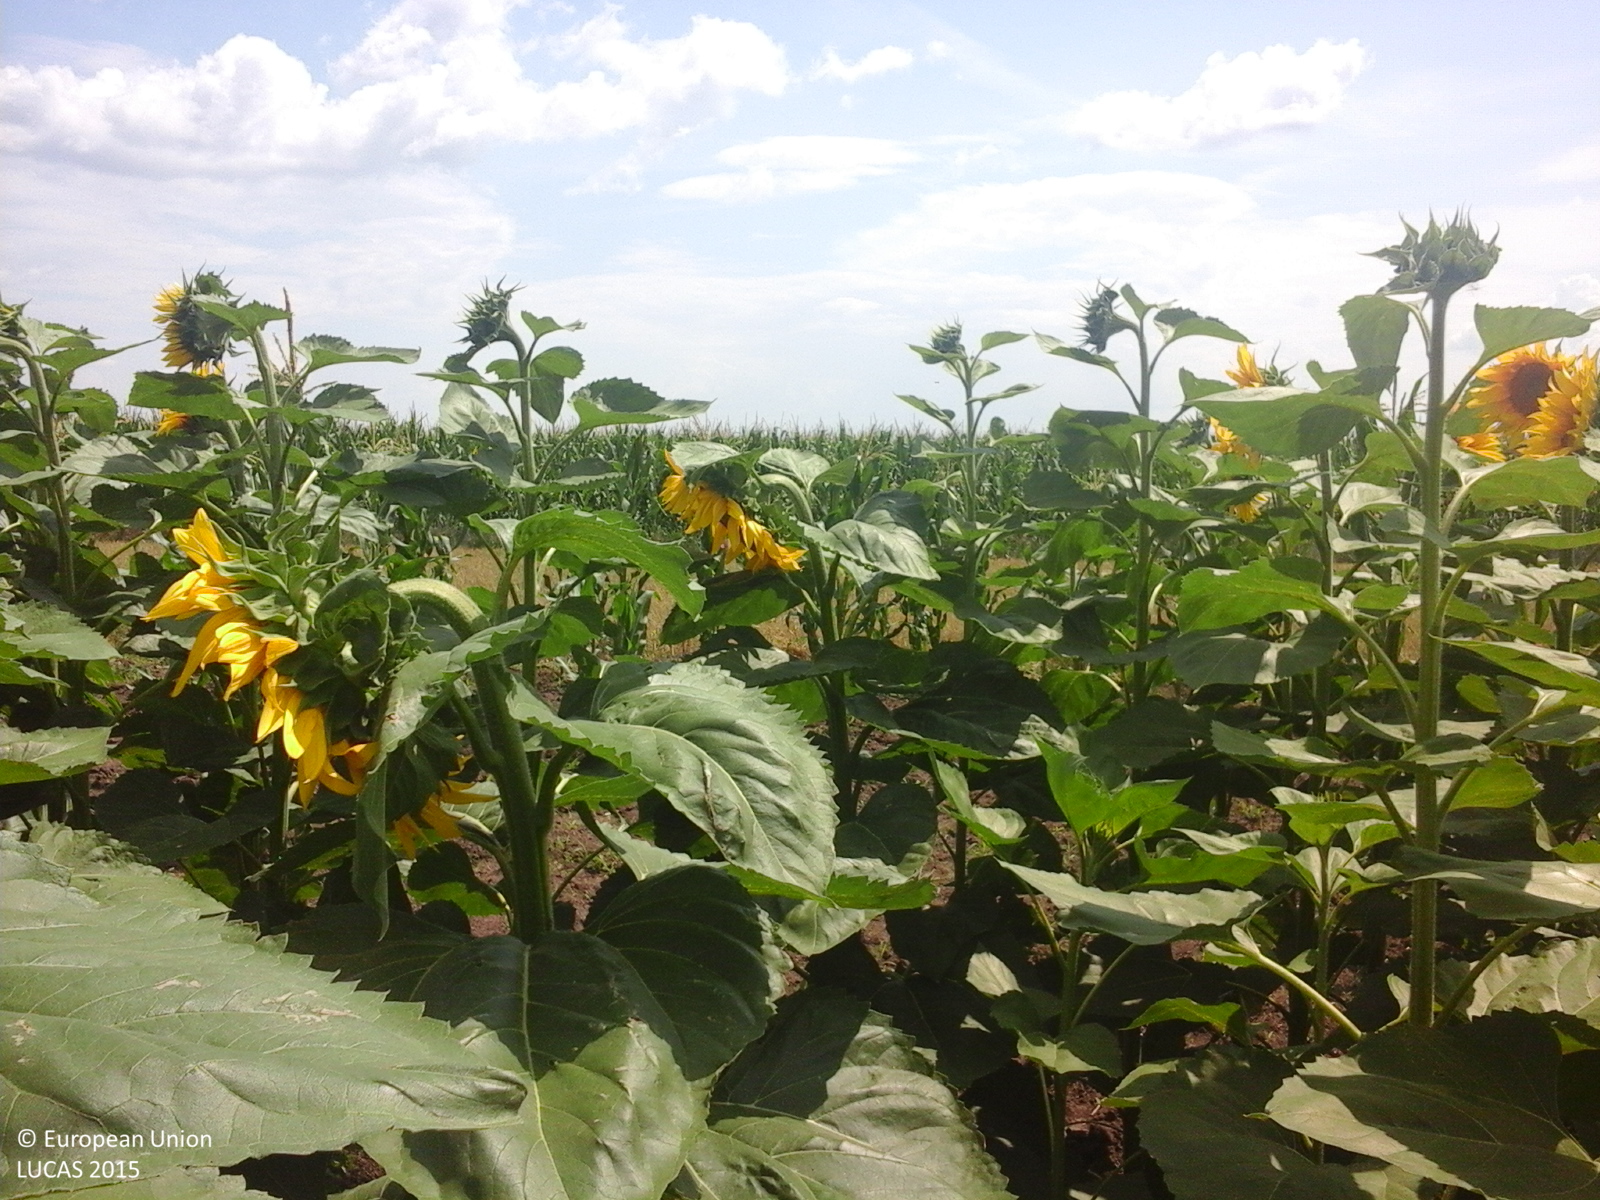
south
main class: Cropland
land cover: Sunflower
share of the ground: > 75 %
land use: Agriculture (excluding fallow land and kitchen gardens)
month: July
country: RO
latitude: 43.8549
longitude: 24.3820
